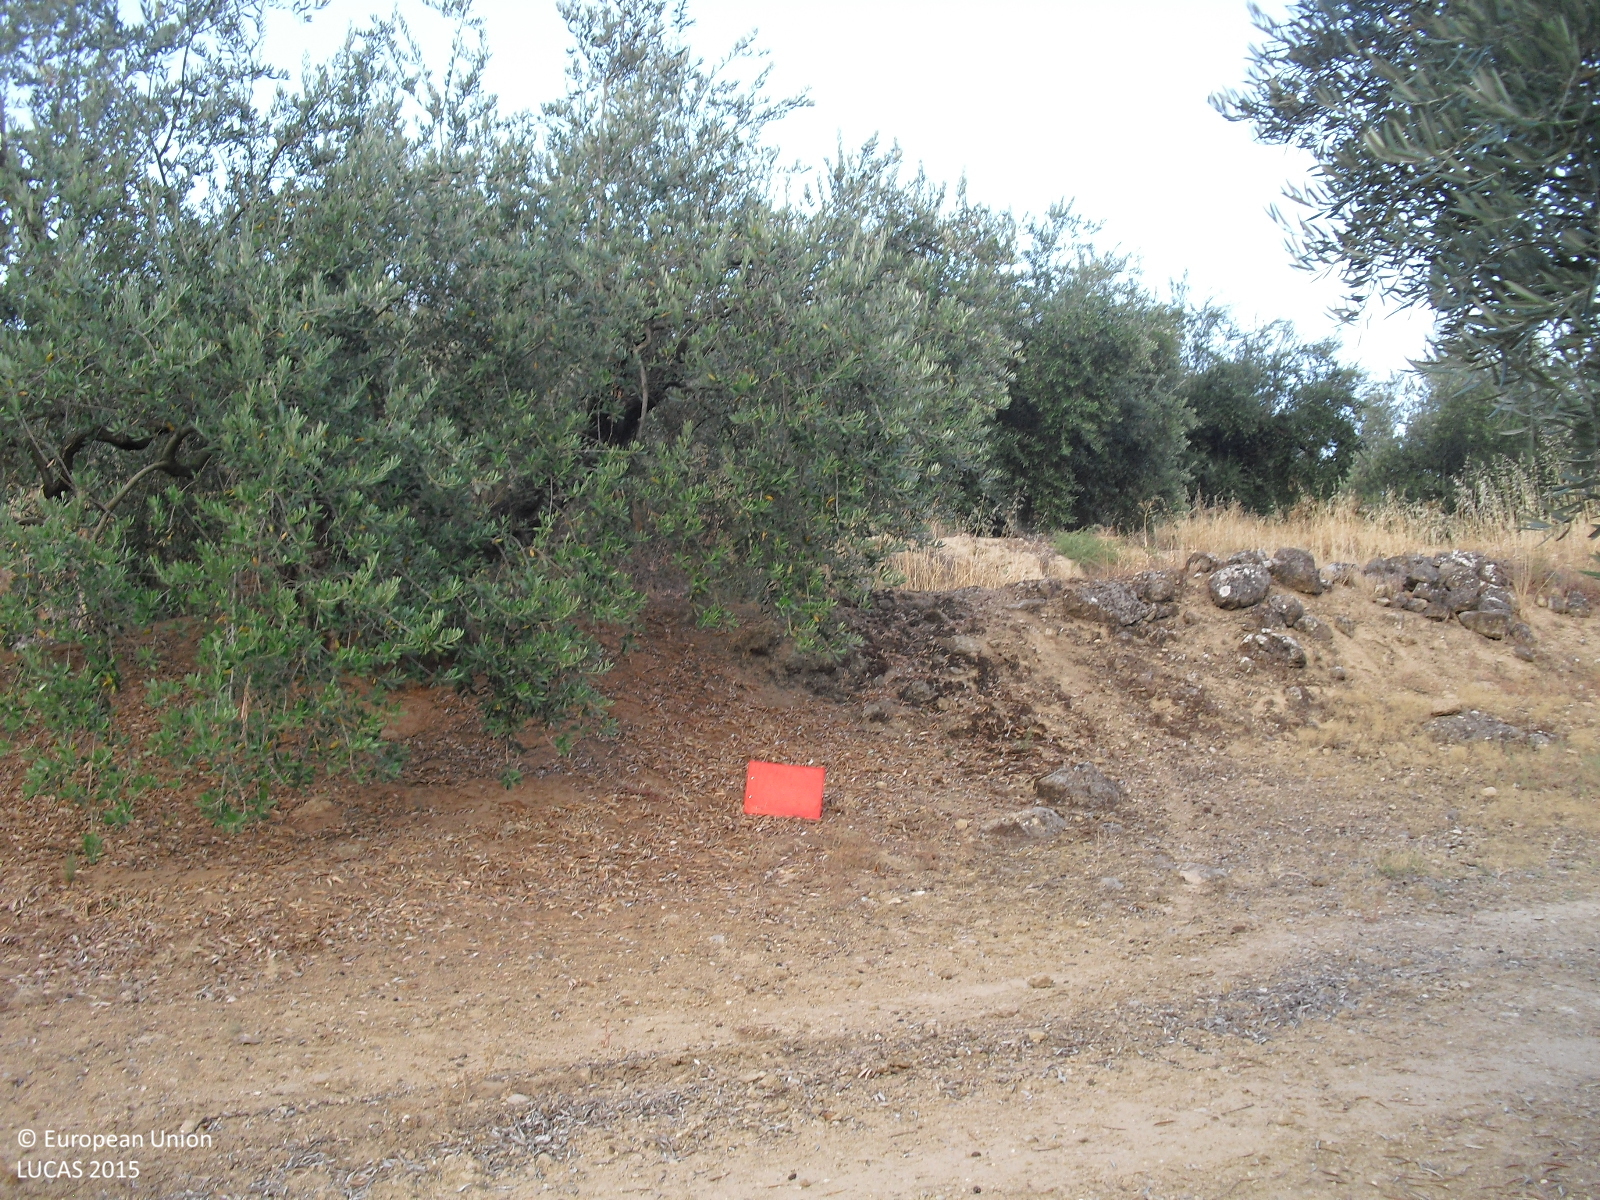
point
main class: Cropland
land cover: Olive groves
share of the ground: 25 - 50 %
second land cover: Other bare soil
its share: > 75 %
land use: Agriculture (excluding fallow land and kitchen gardens)
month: August
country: ES
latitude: 37.2830
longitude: -4.1973
